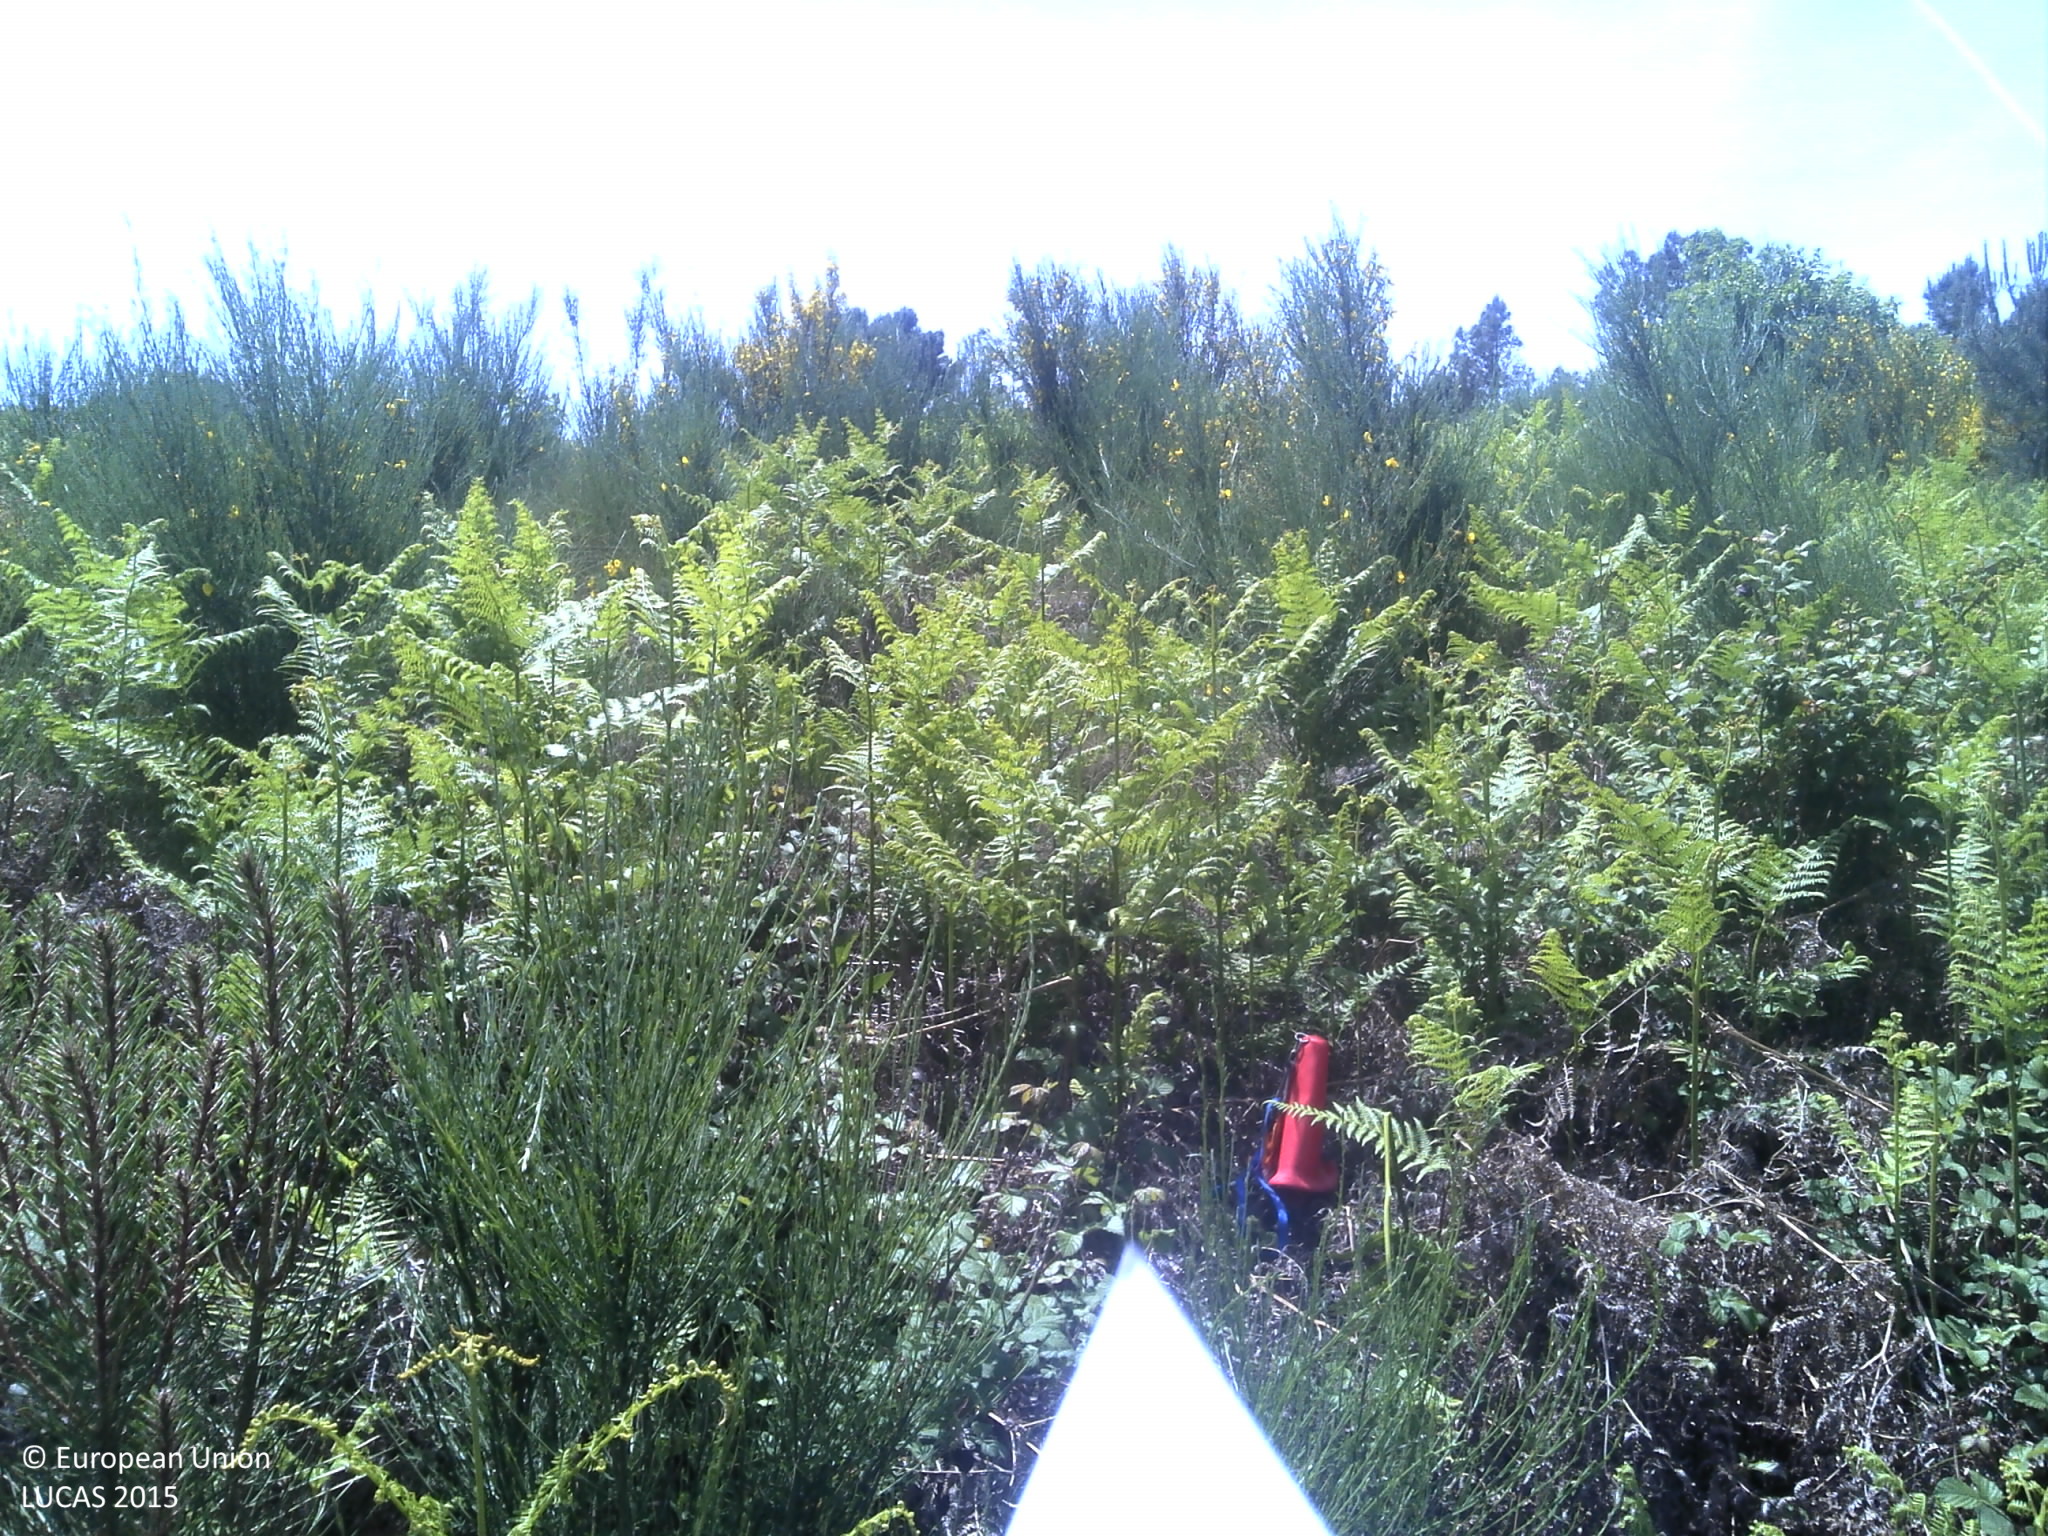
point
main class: Shrubland
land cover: Shrubland without tree cover
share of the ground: 25 - 50 %
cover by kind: shrubs 100 %
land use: Abandoned areas
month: May
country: PT
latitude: 40.5646
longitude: -7.3889
